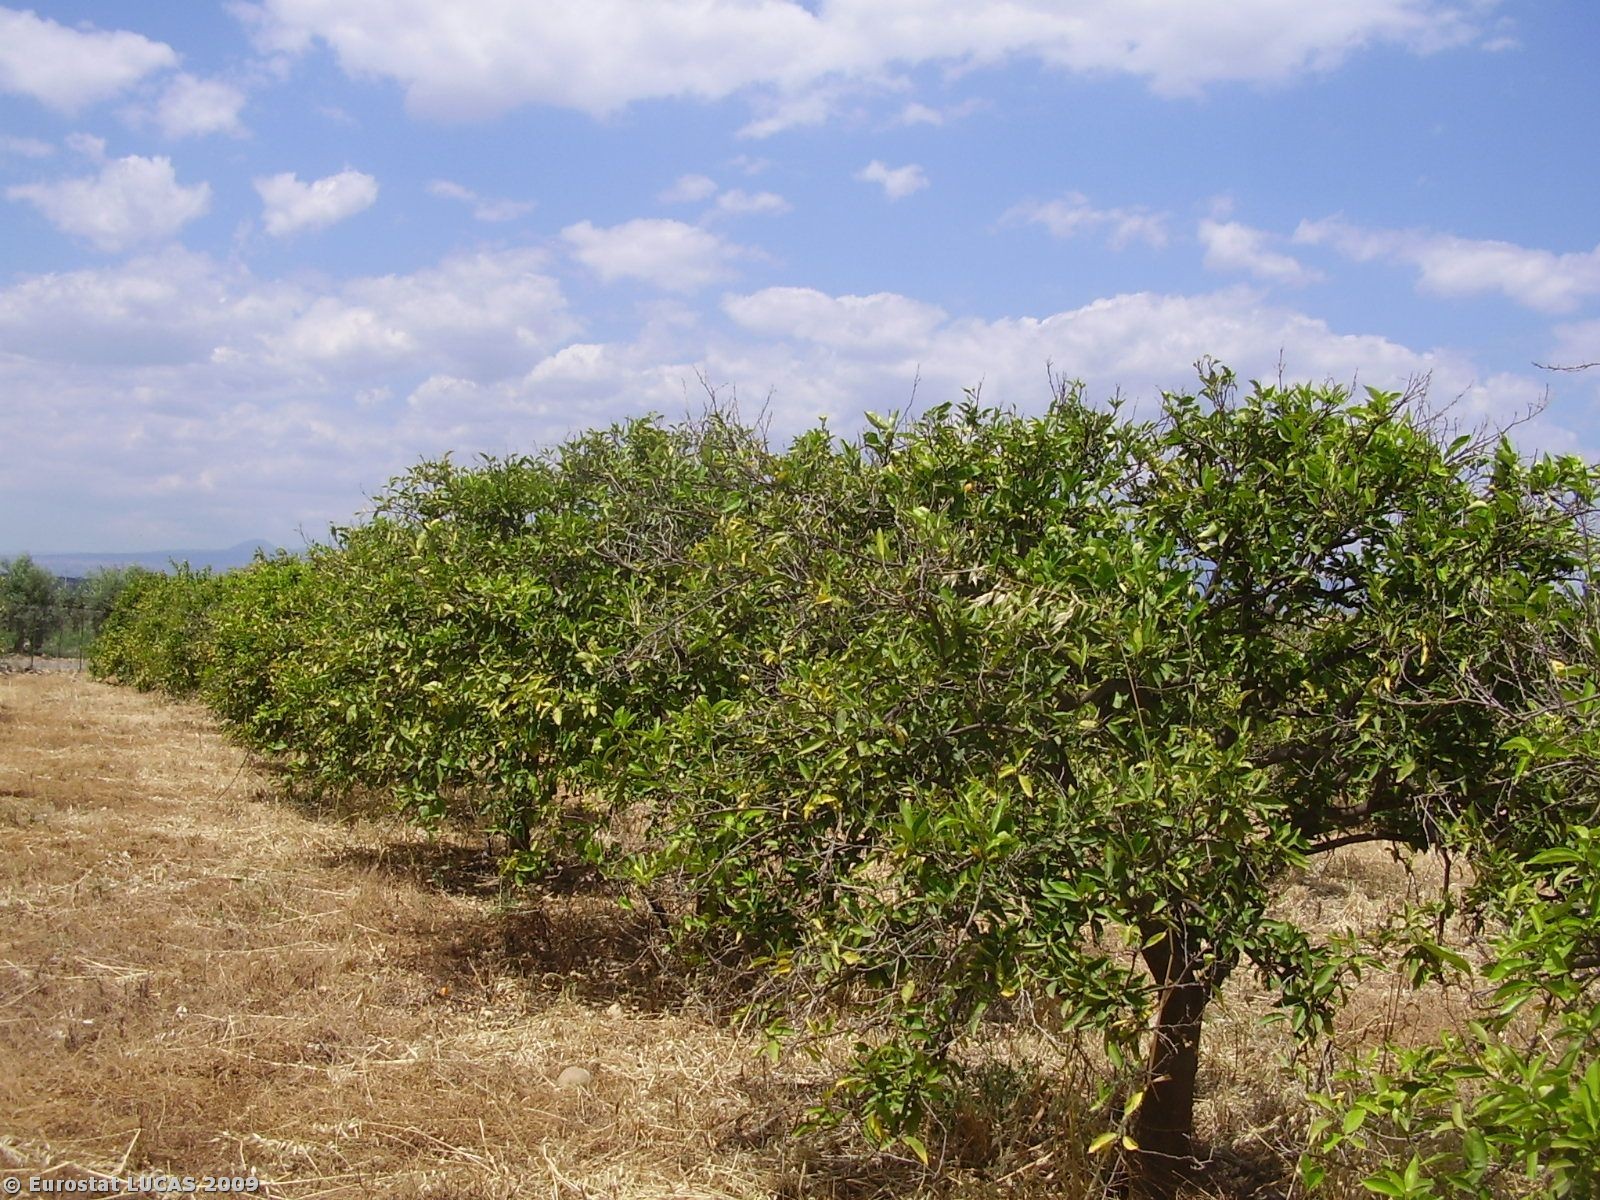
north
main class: Cropland
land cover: Oranges
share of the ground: 25 - 50 %
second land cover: Spontaneously vegetated surfaces
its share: > 75 %
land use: Agriculture (excluding fallow land and kitchen gardens)
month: June
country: IT
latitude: 37.4754
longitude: 14.9059
